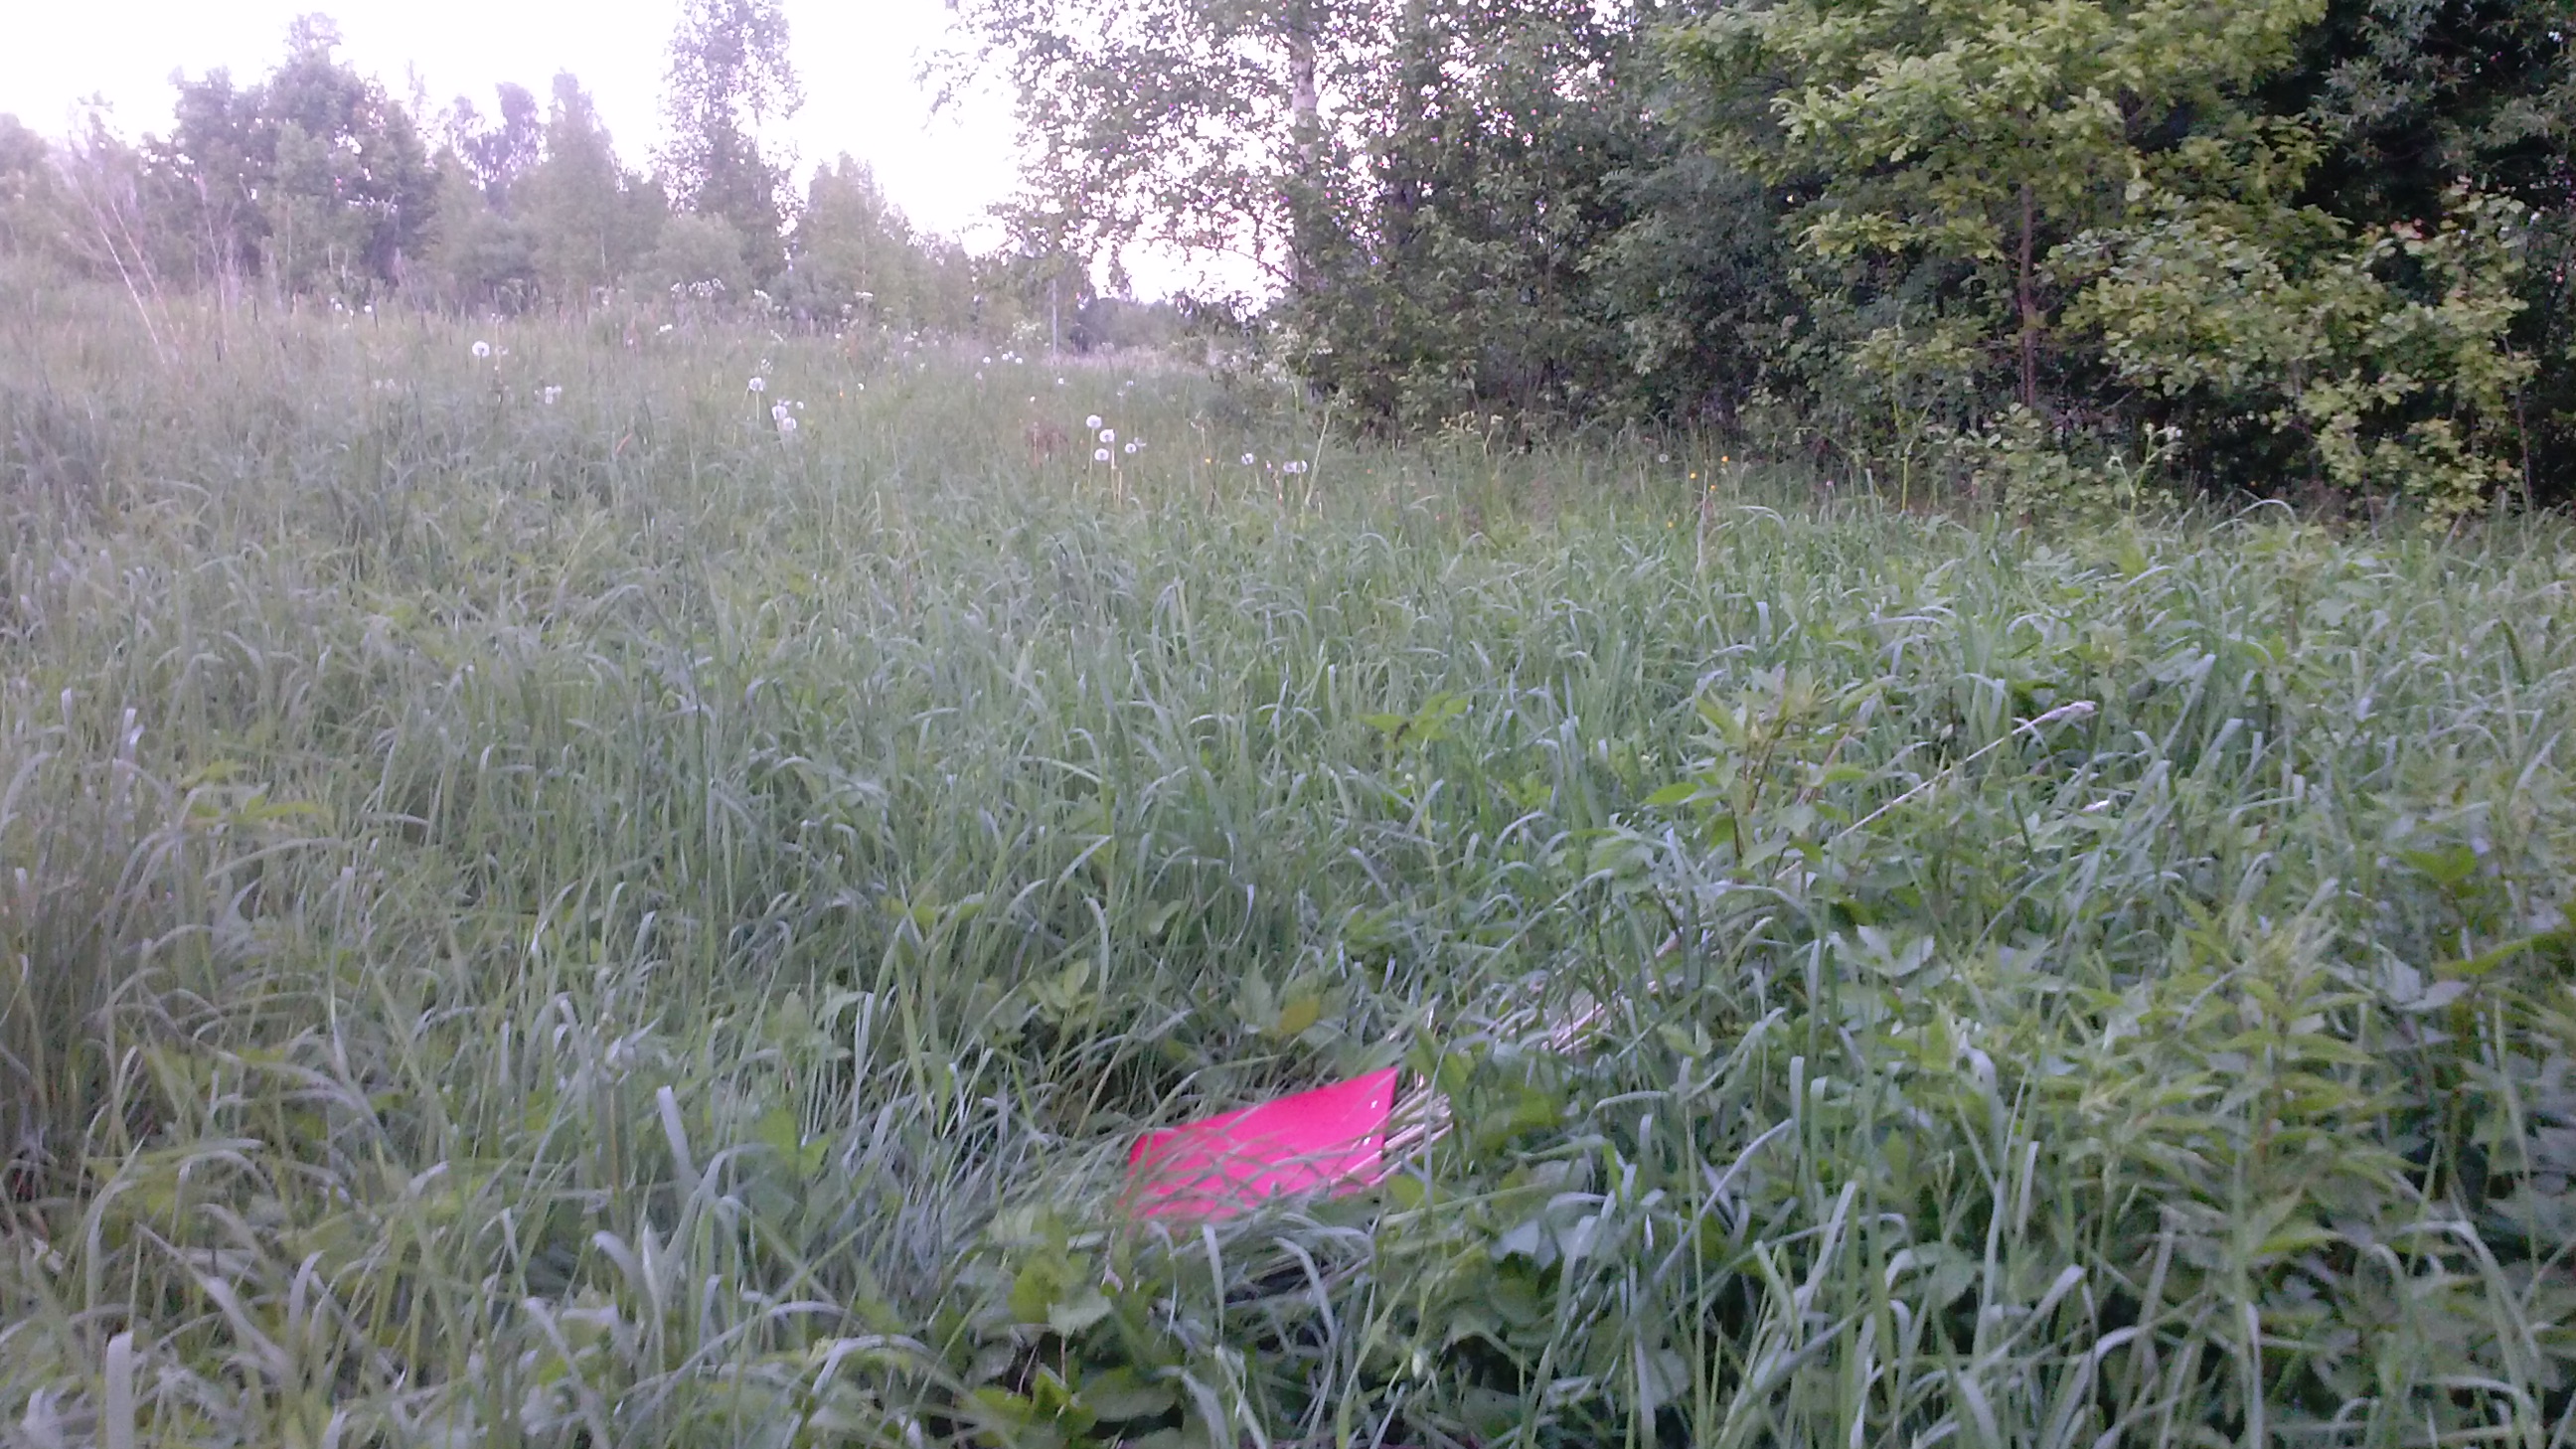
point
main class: Woodland
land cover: Broadleaved woodland
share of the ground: 25 - 50 %
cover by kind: herbaceous plants 50 %, broadleaved forest trees 40 %, shrubs 10 %
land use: Semi-natural and natural areas not in use
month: June
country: LV
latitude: 56.3825
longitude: 27.9619
